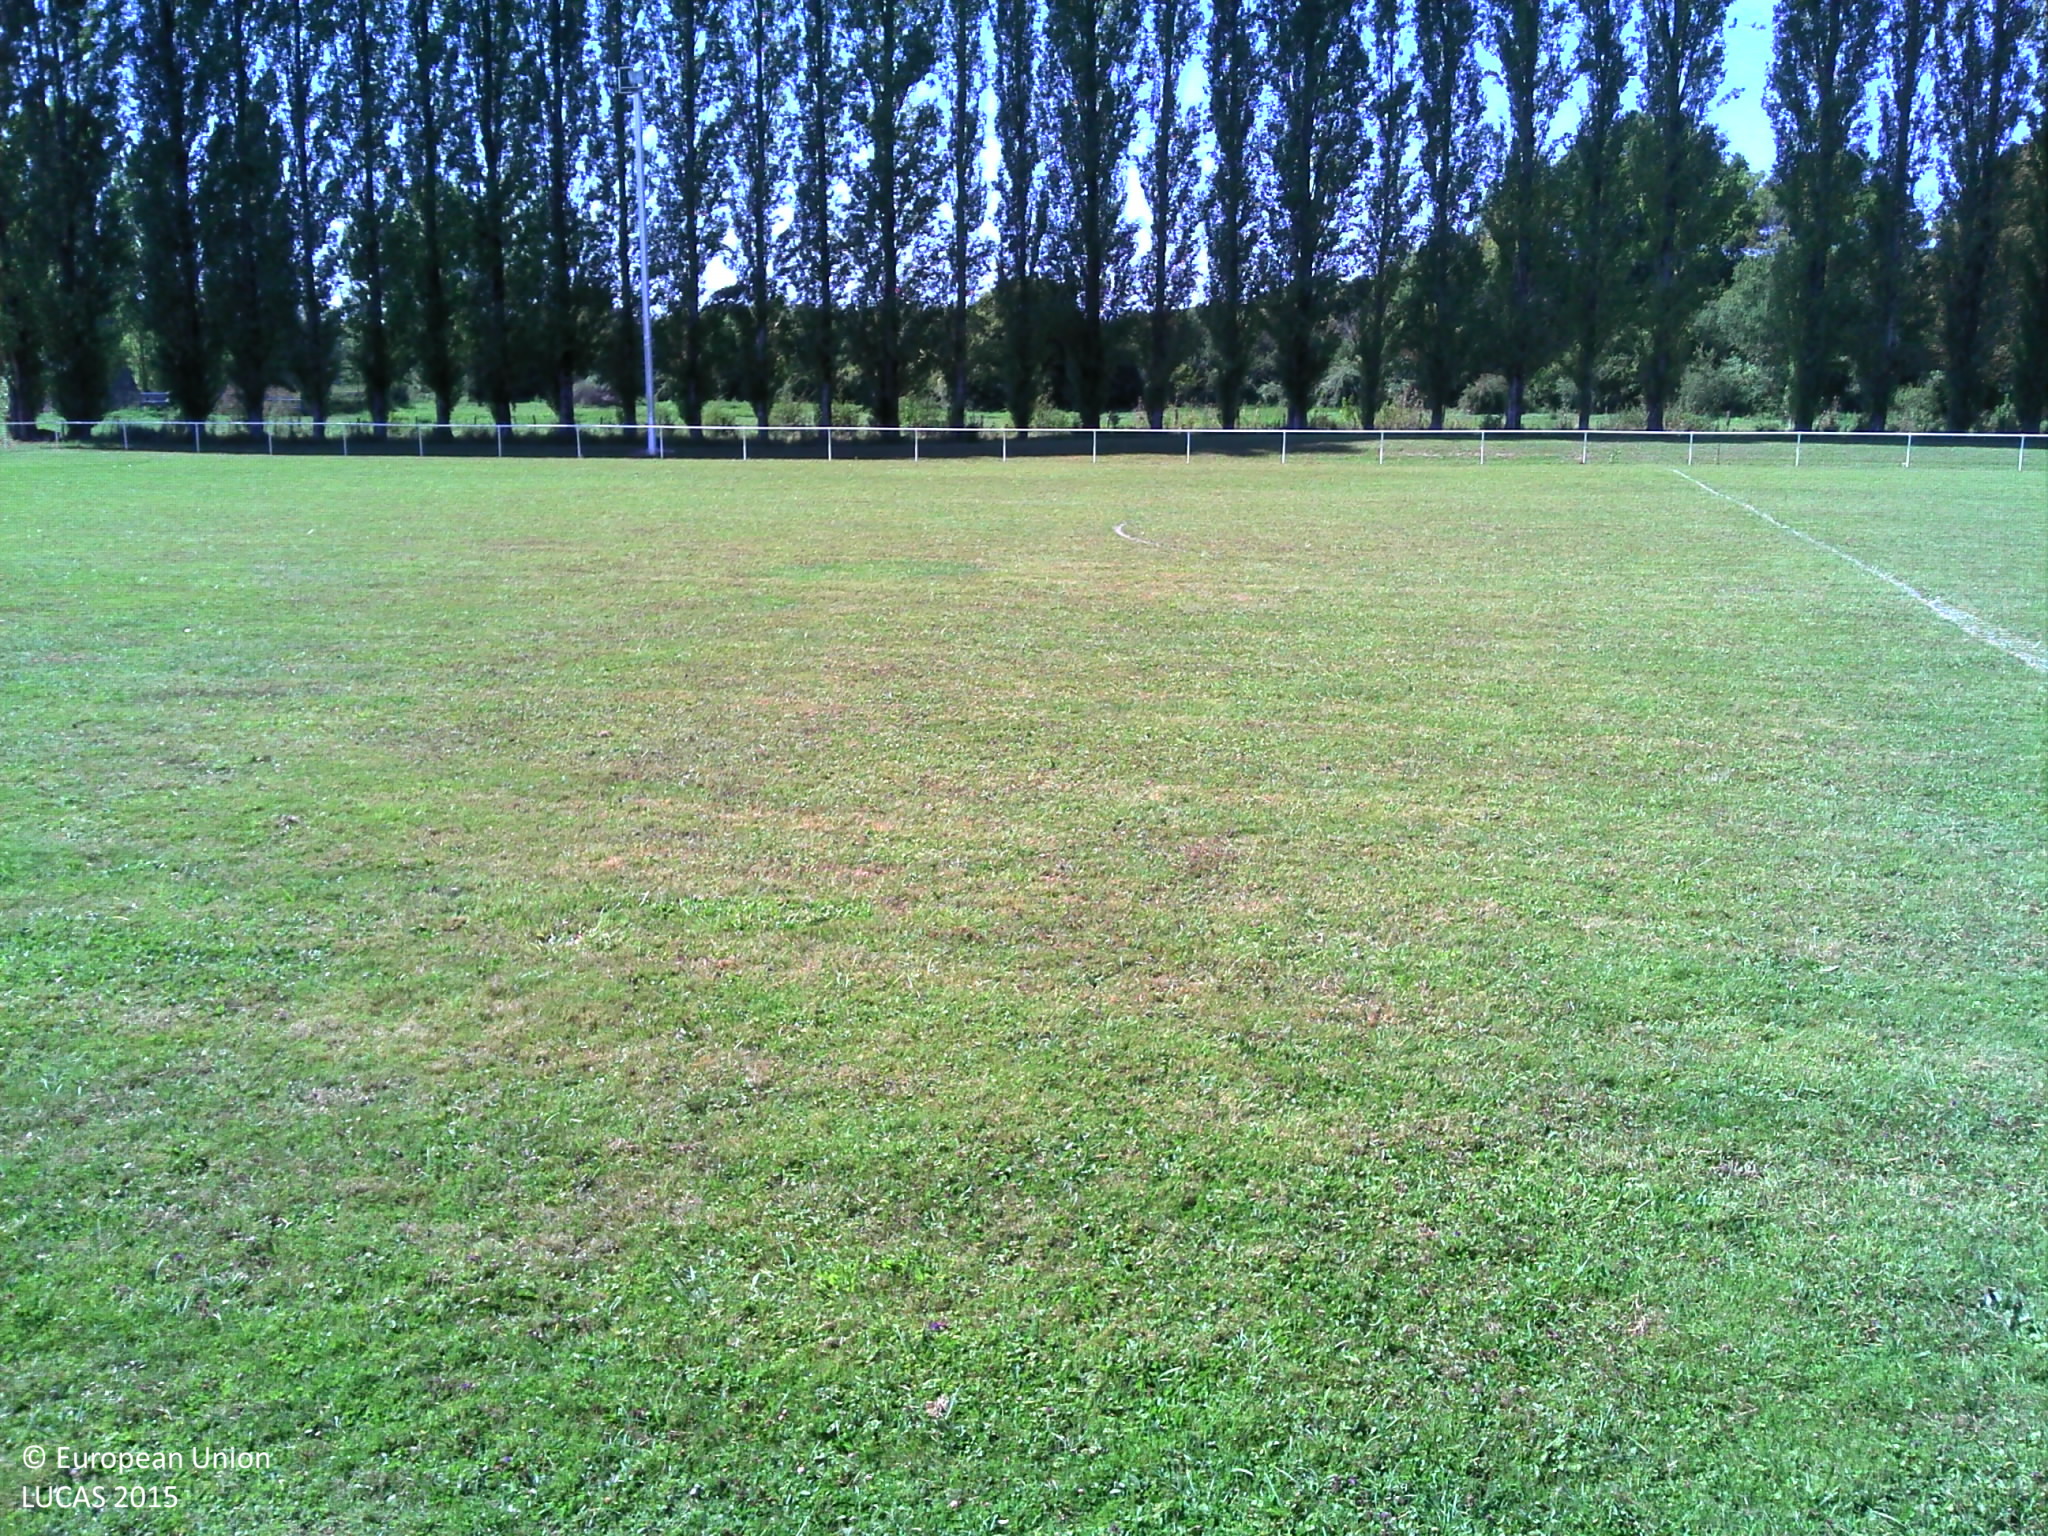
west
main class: Grassland
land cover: Grassland without tree/shrub cover
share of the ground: > 75 %
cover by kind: herbaceous plants 100 %
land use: Sport
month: September
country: FR
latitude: 47.1198
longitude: 1.5390
